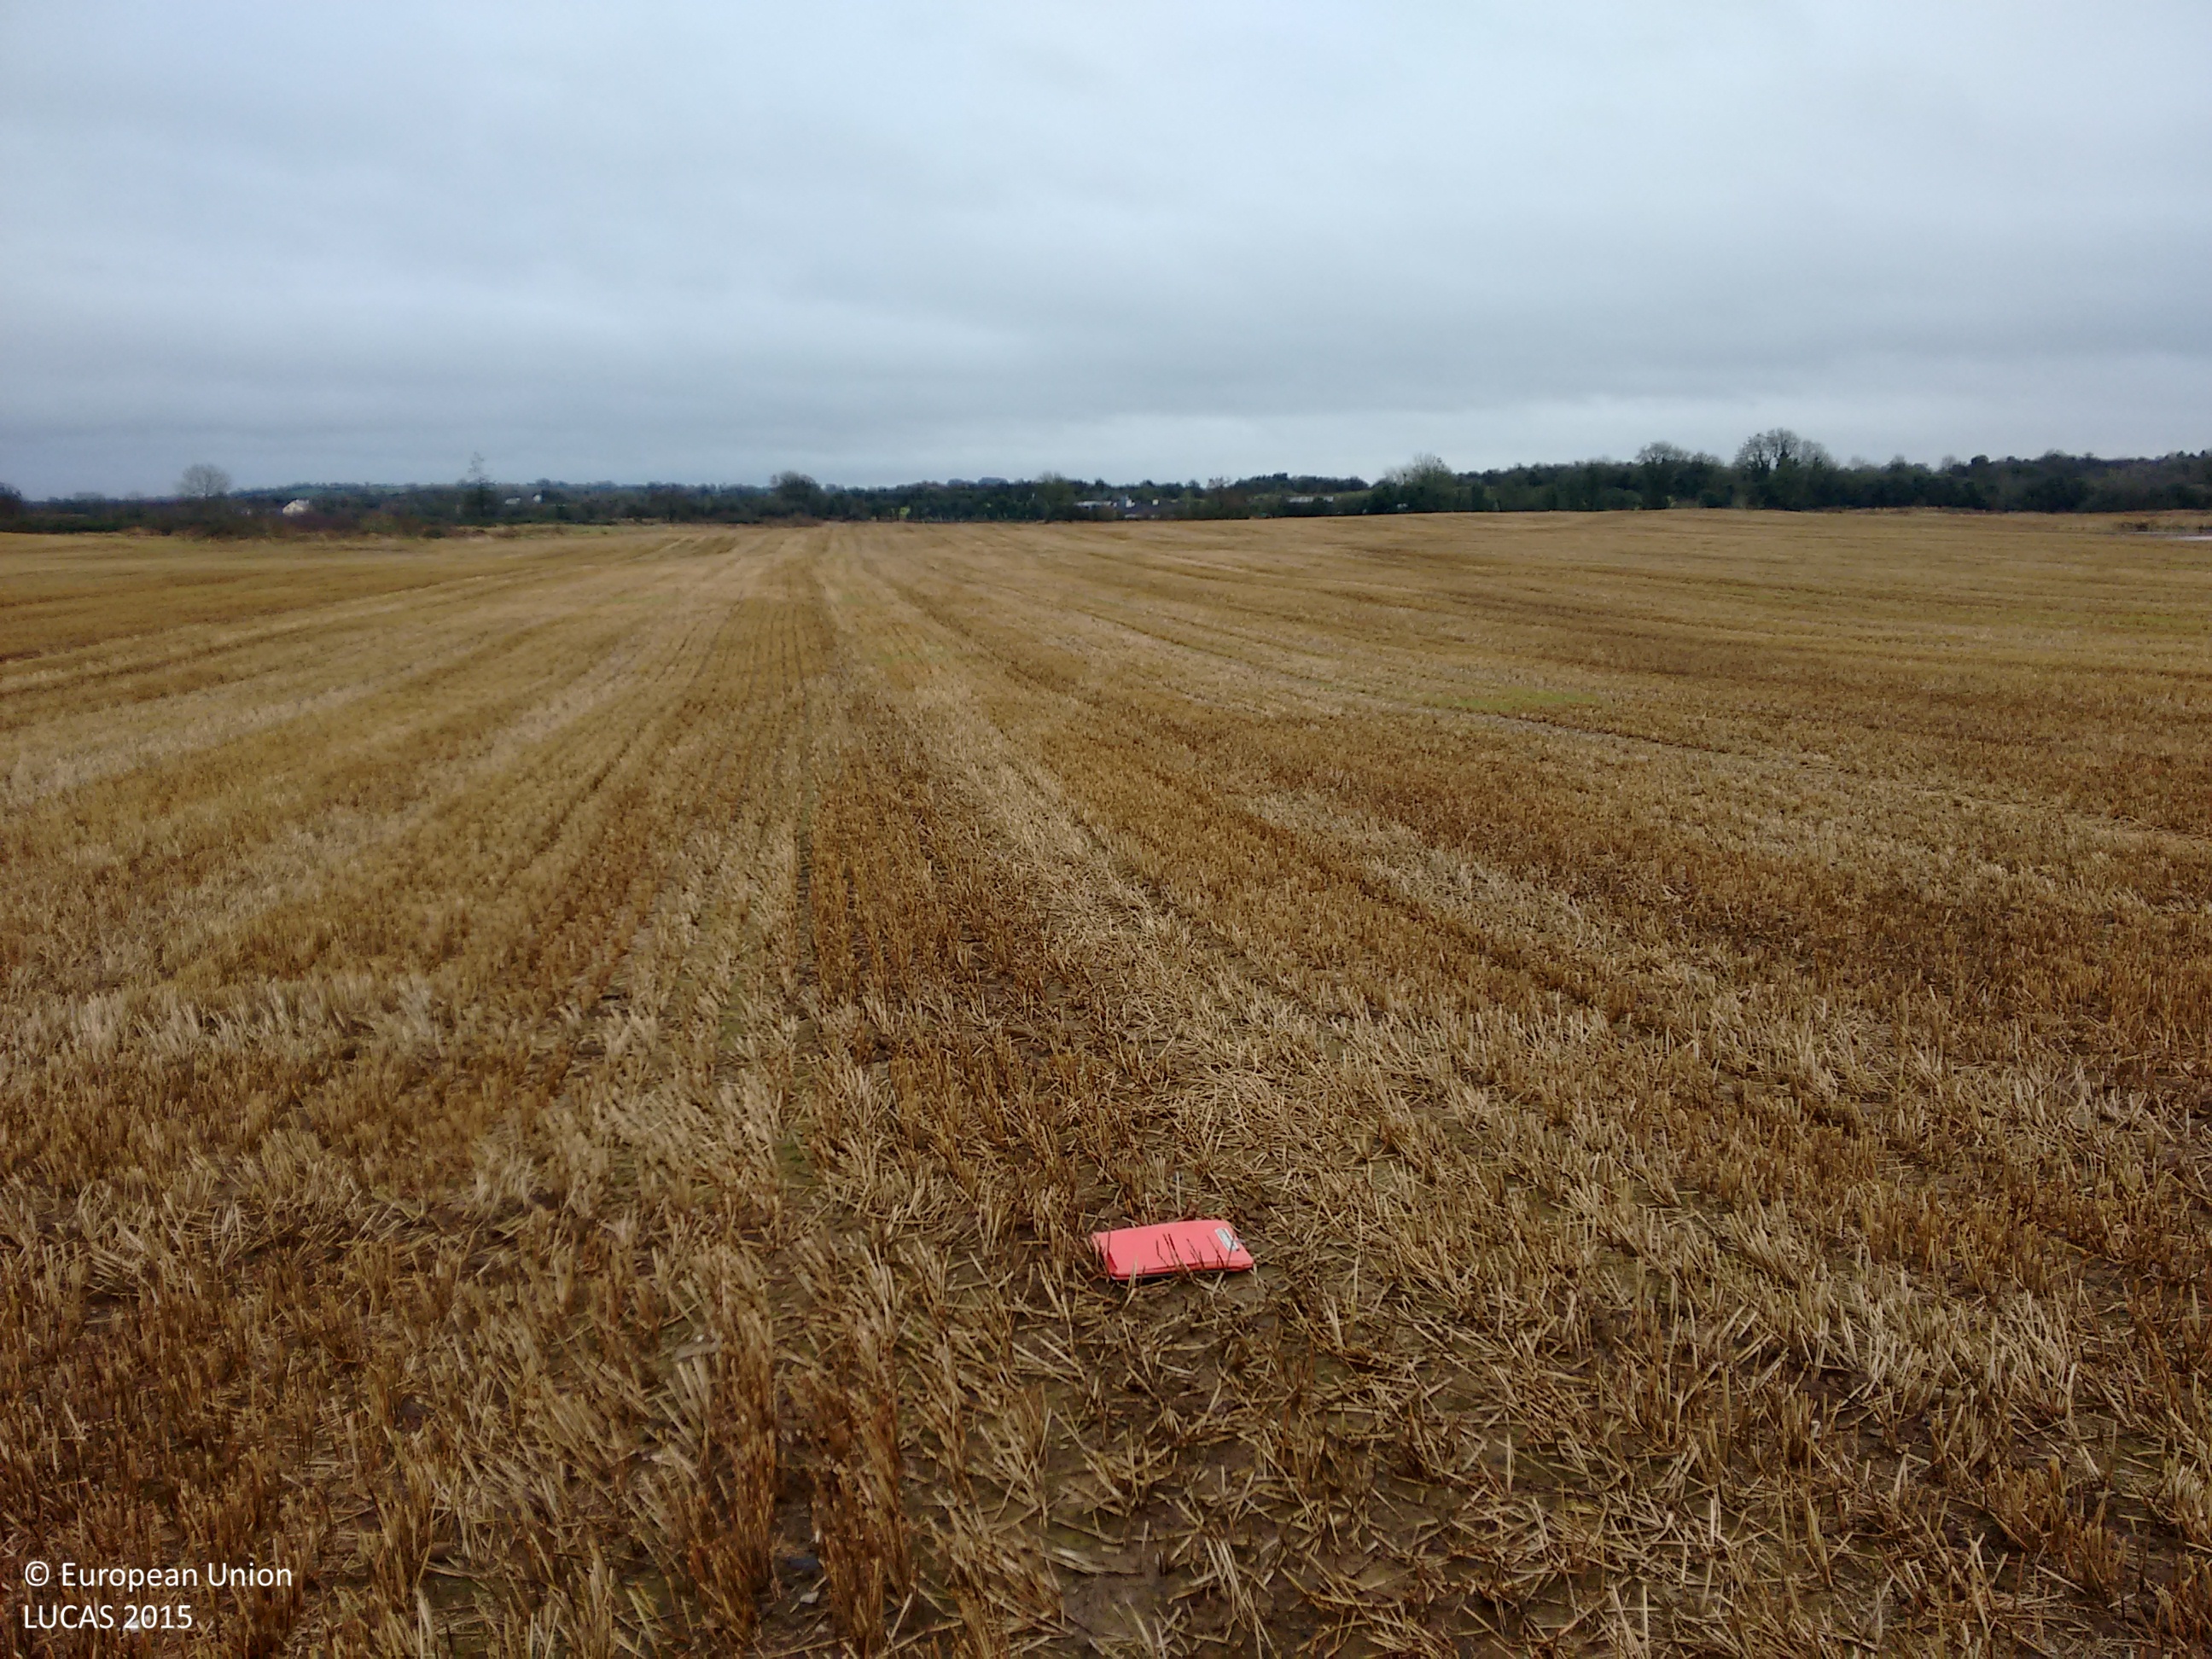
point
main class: Cropland
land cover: Barley
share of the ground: > 75 %
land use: Agriculture (excluding fallow land and kitchen gardens)
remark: Harvested field
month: December
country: IE
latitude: 53.5329
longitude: -7.6177
